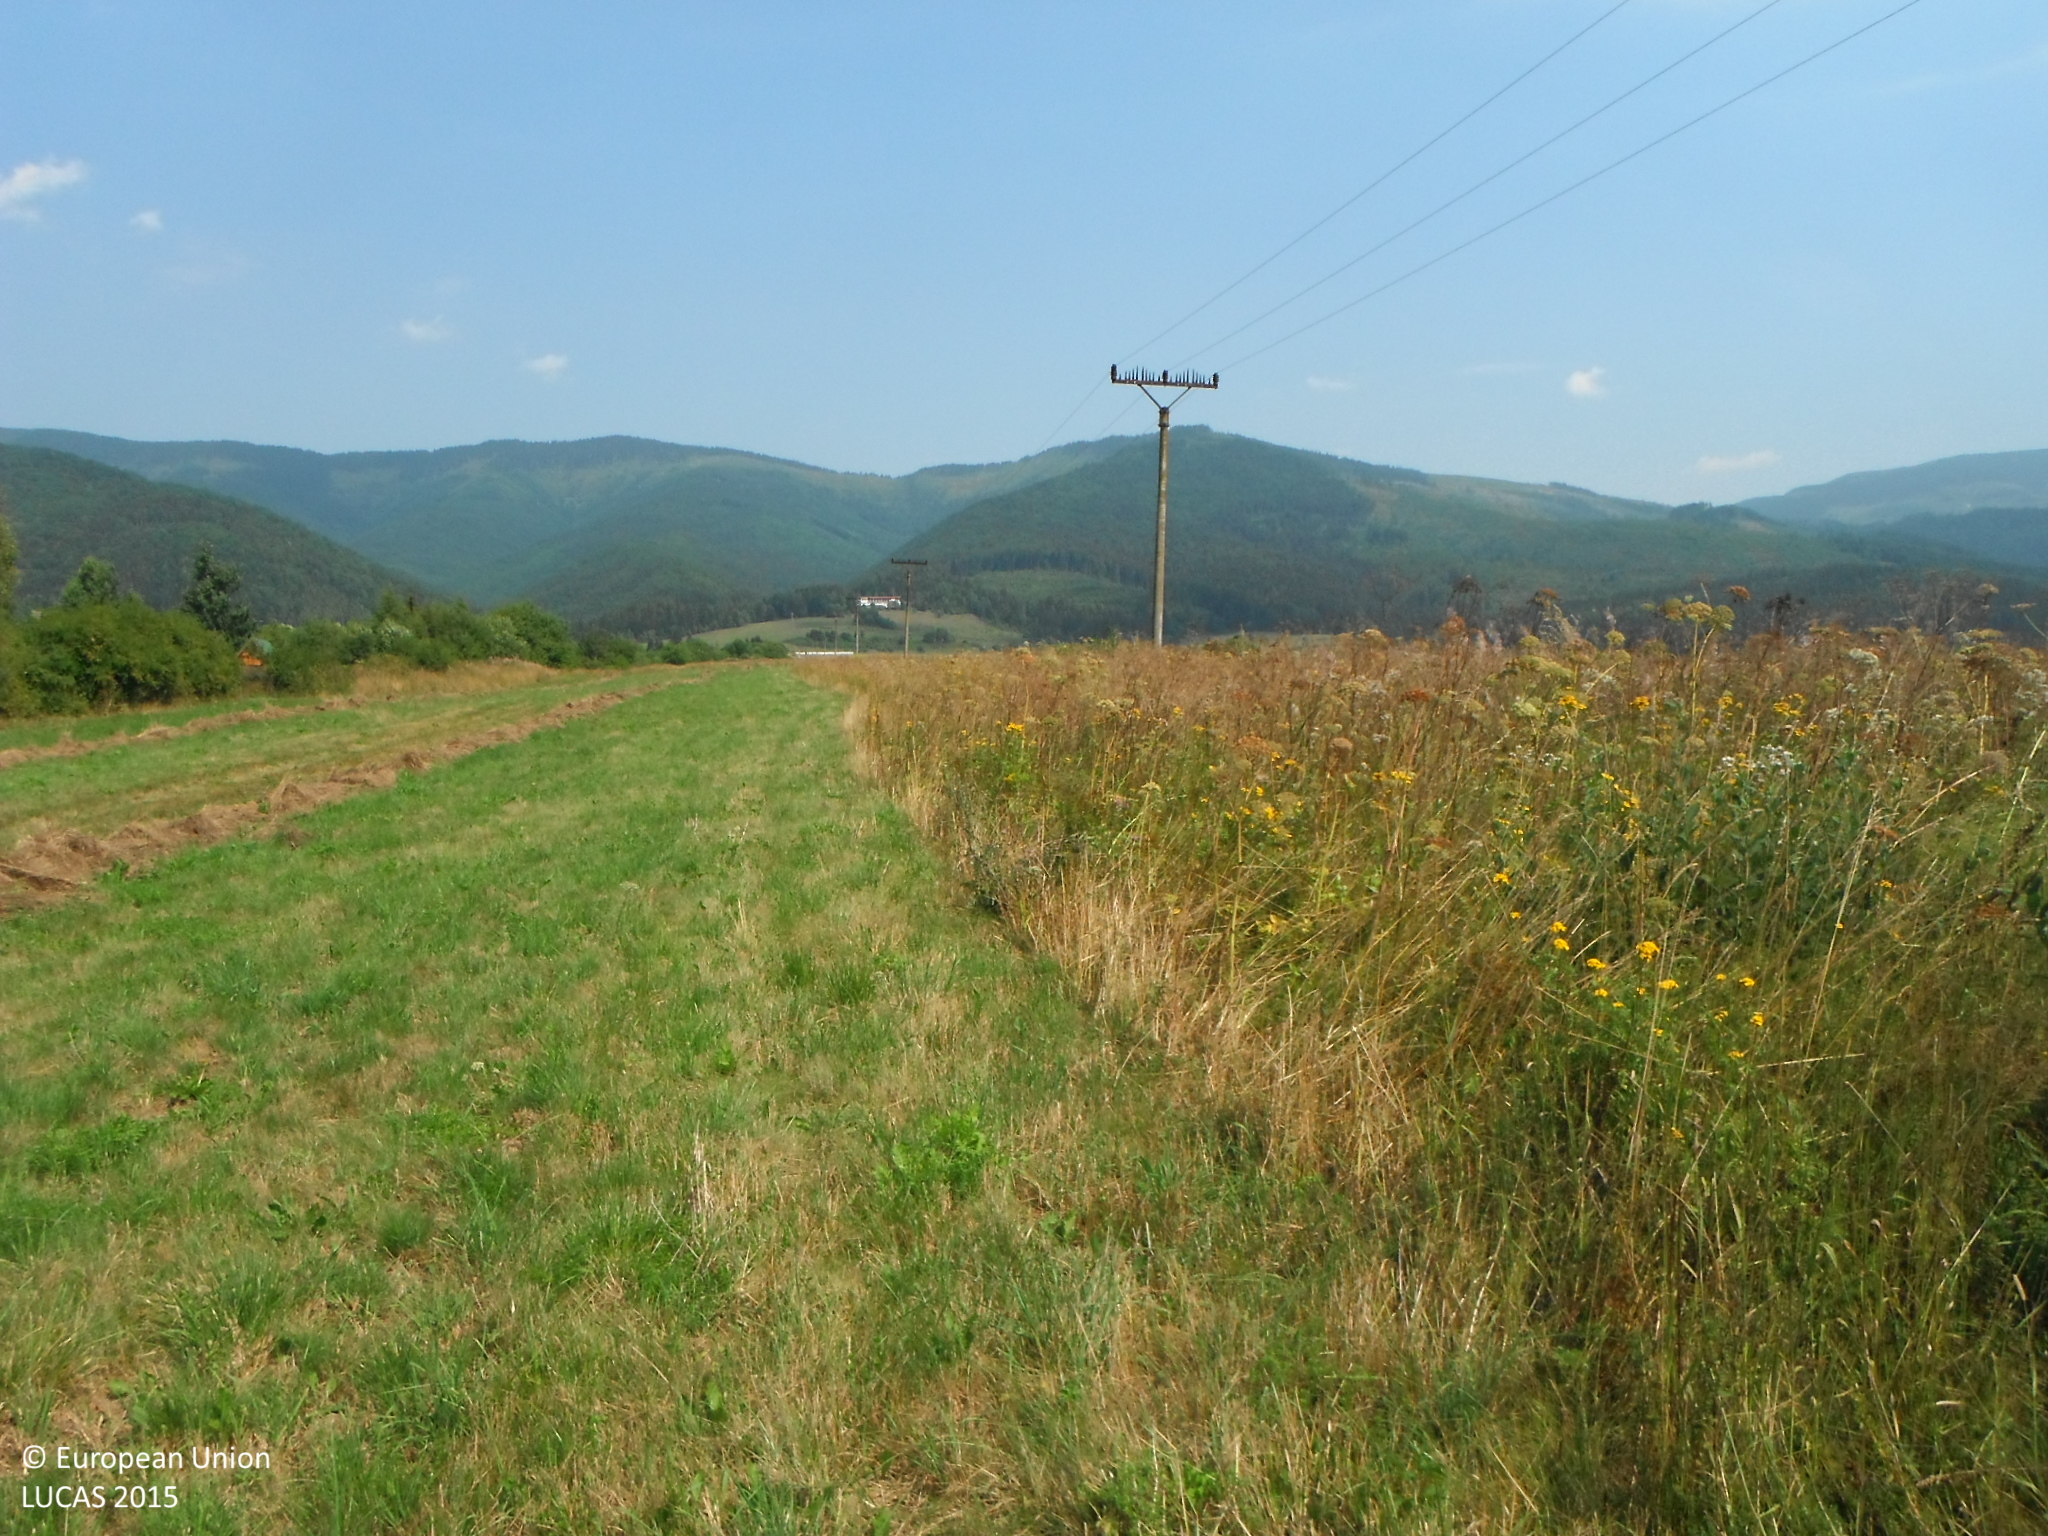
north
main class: Grassland
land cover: Grassland without tree/shrub cover
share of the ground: > 75 %
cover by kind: herbaceous plants 100 %
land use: Agriculture (excluding fallow land and kitchen gardens)
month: August
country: SK
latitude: 48.8633
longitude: 19.9124
